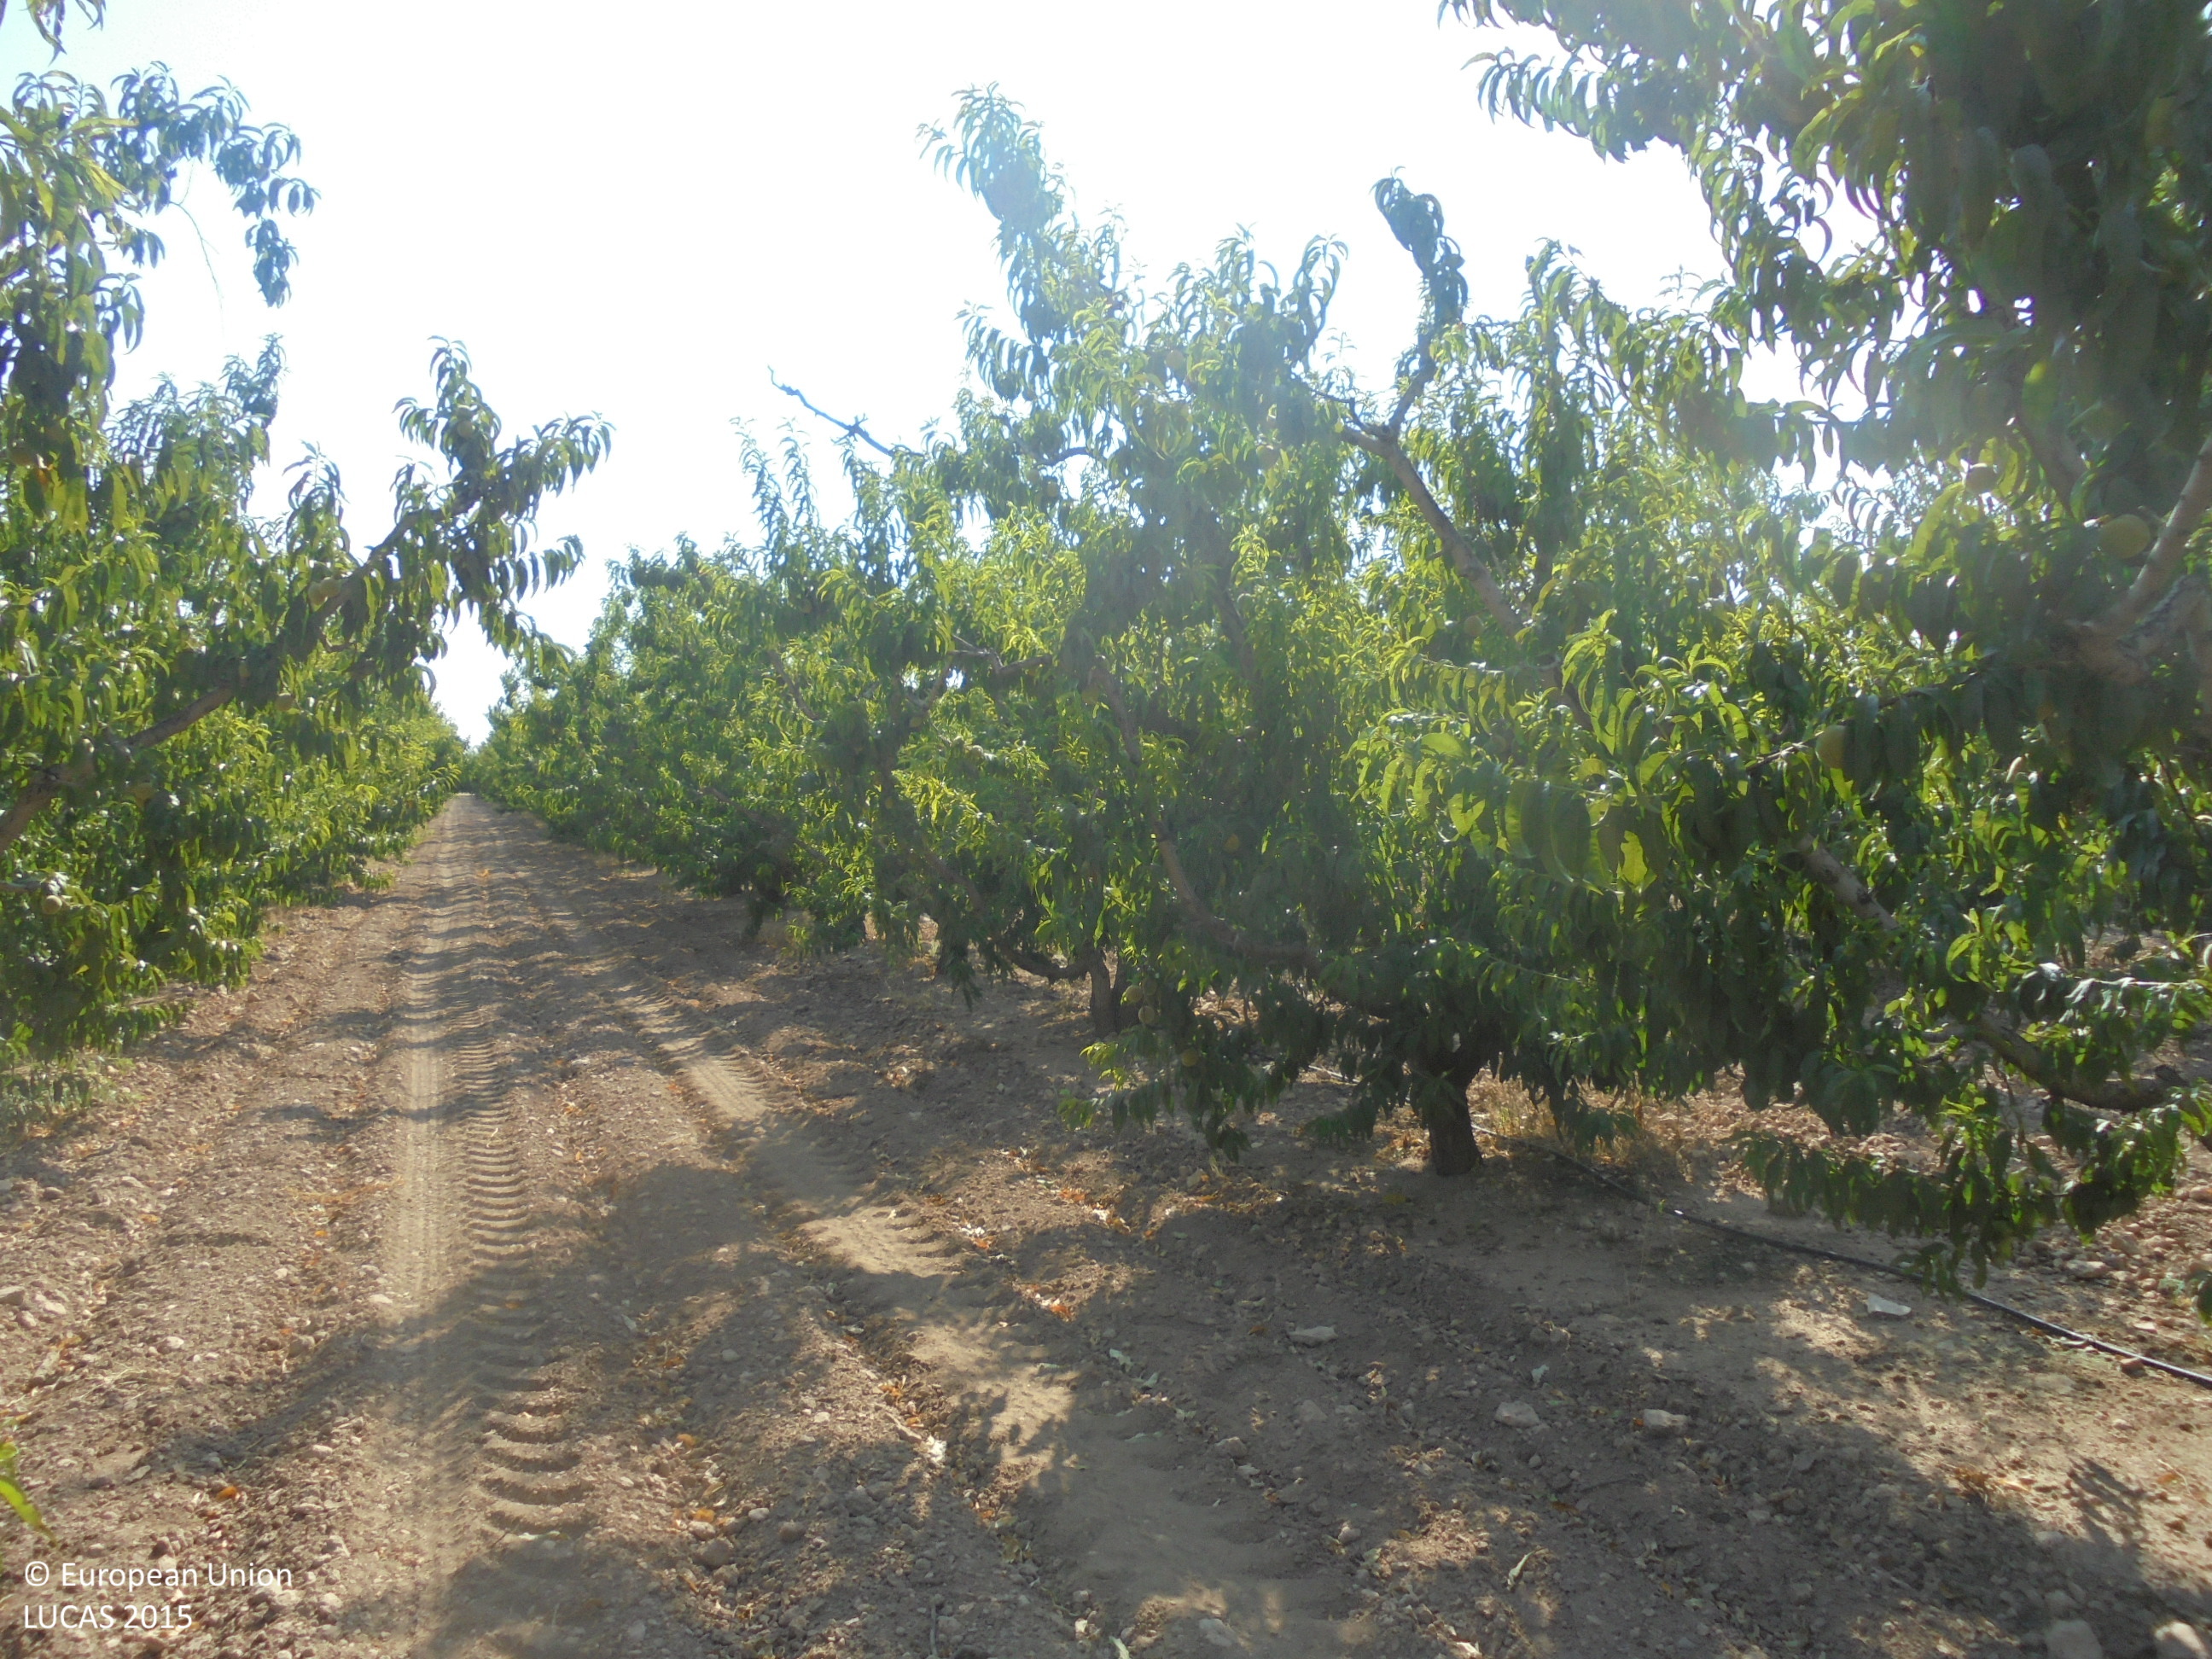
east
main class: Cropland
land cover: Other fruit trees and berries
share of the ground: > 75 %
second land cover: Other bare soil
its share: > 75 %
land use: Agriculture (excluding fallow land and kitchen gardens)
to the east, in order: Other fruit trees and berries; Other bare soil; Tracks; Other fruit trees and berries; Grassland without tree/shrub cover
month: July
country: ES
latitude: 38.5500
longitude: -1.4783
